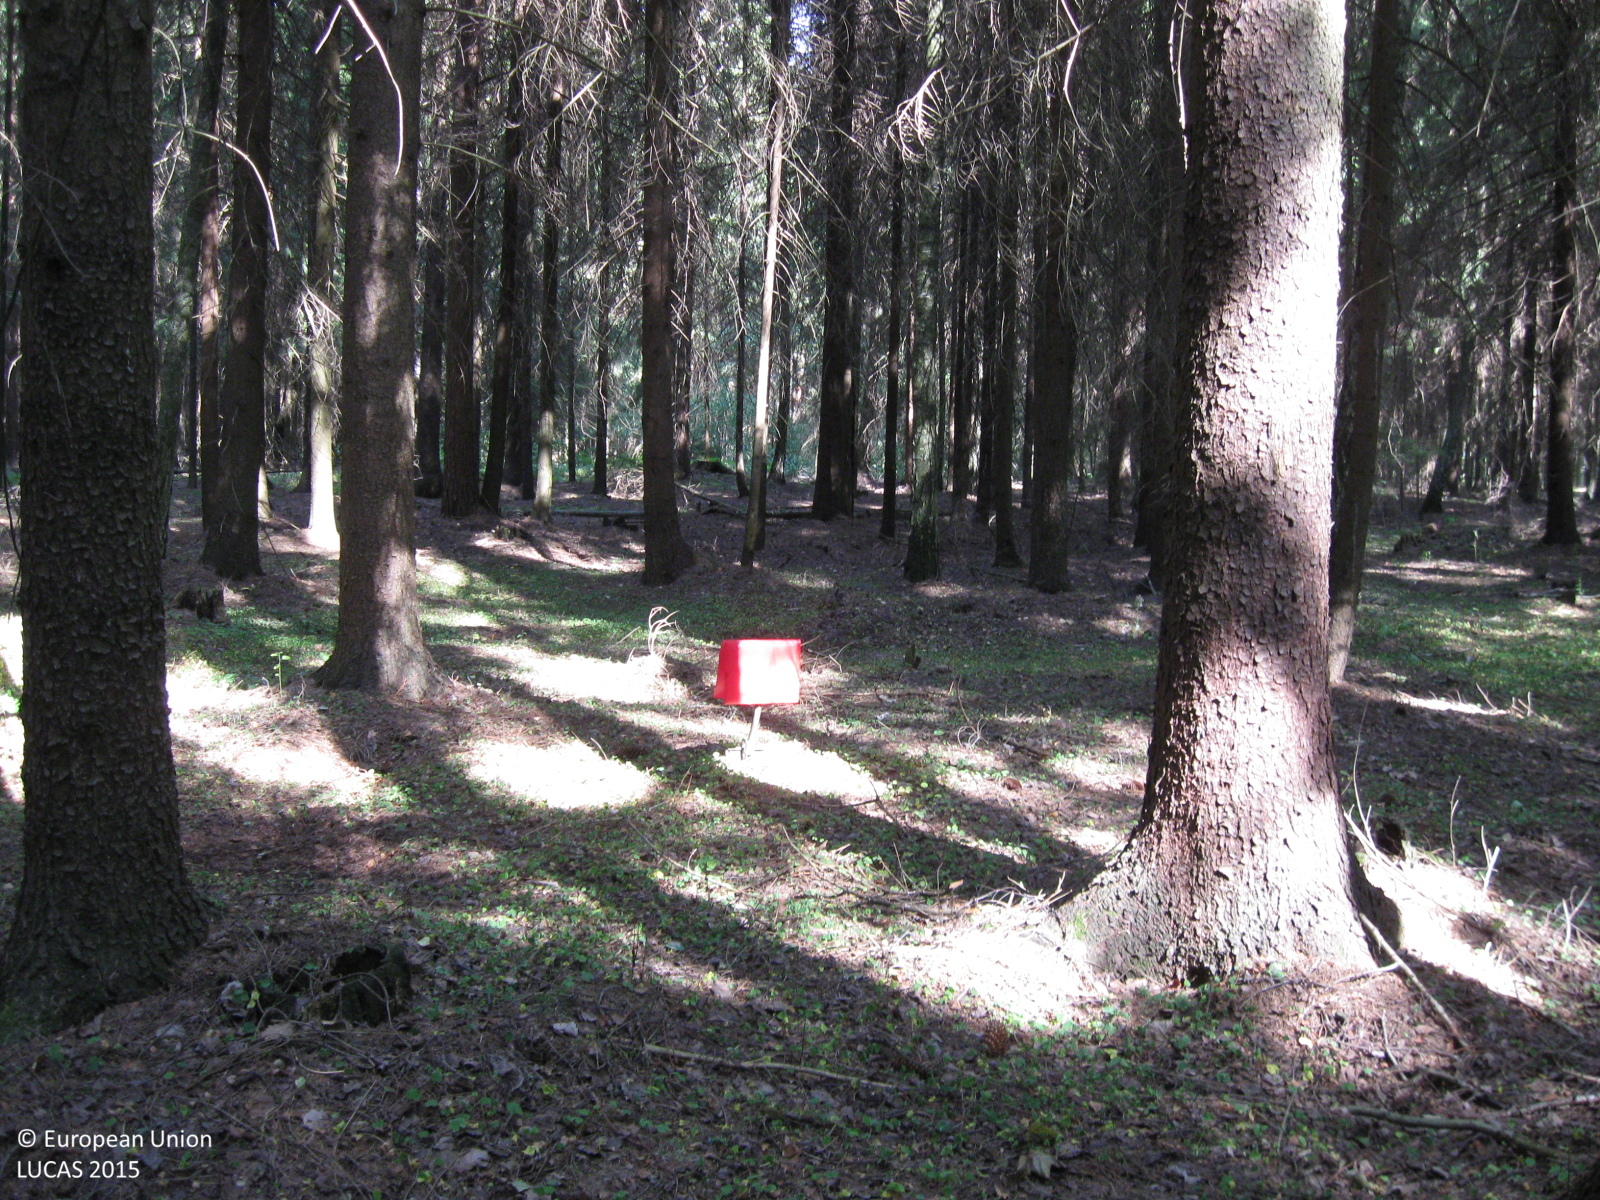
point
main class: Woodland
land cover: Spruce dominated coniferous woodland
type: hemiboreal forest and nemoral coniferous forest and mixed broadleaved-coniferous forest
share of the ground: > 75 %
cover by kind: coniferous forest trees 85 %, broadleaved forest trees 10 %, herbaceous plants 5 %
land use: Forestry
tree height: > 5 m
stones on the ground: < 10 %
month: August
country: LT
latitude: 55.2660
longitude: 22.4782
